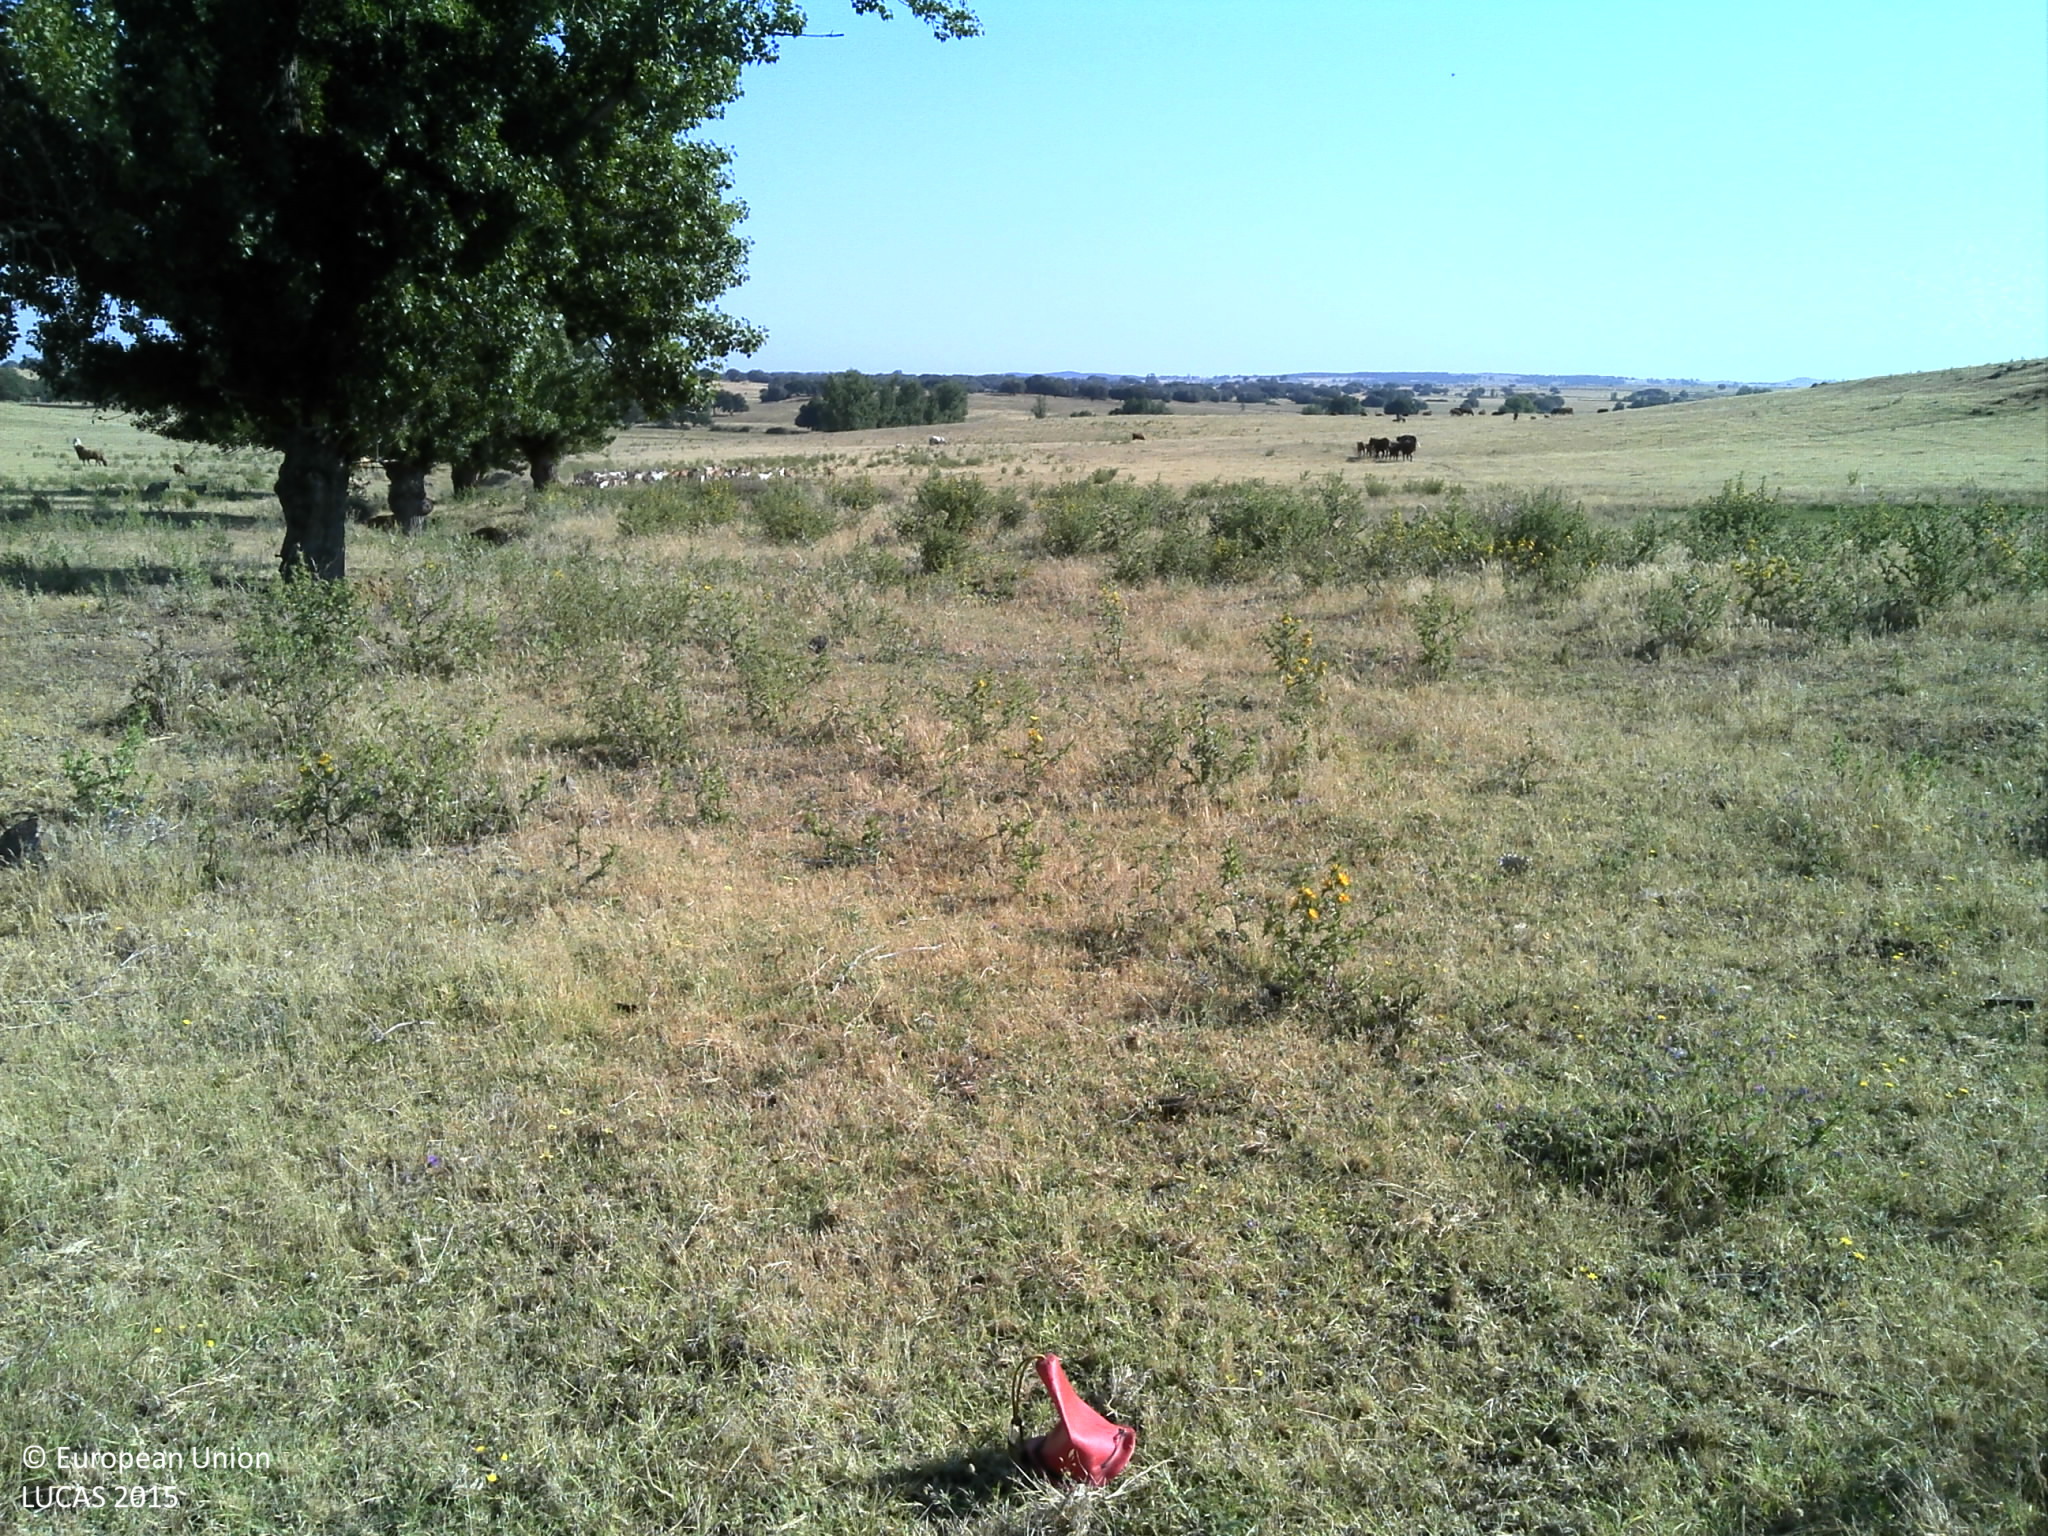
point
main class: Grassland
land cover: Grassland without tree/shrub cover
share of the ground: 25 - 50 %
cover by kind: herbaceous plants 45 %, unconsolidated bare surface 45 %
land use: Agriculture (excluding fallow land and kitchen gardens)
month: June
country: PT
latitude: 38.6514
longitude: -8.0501
